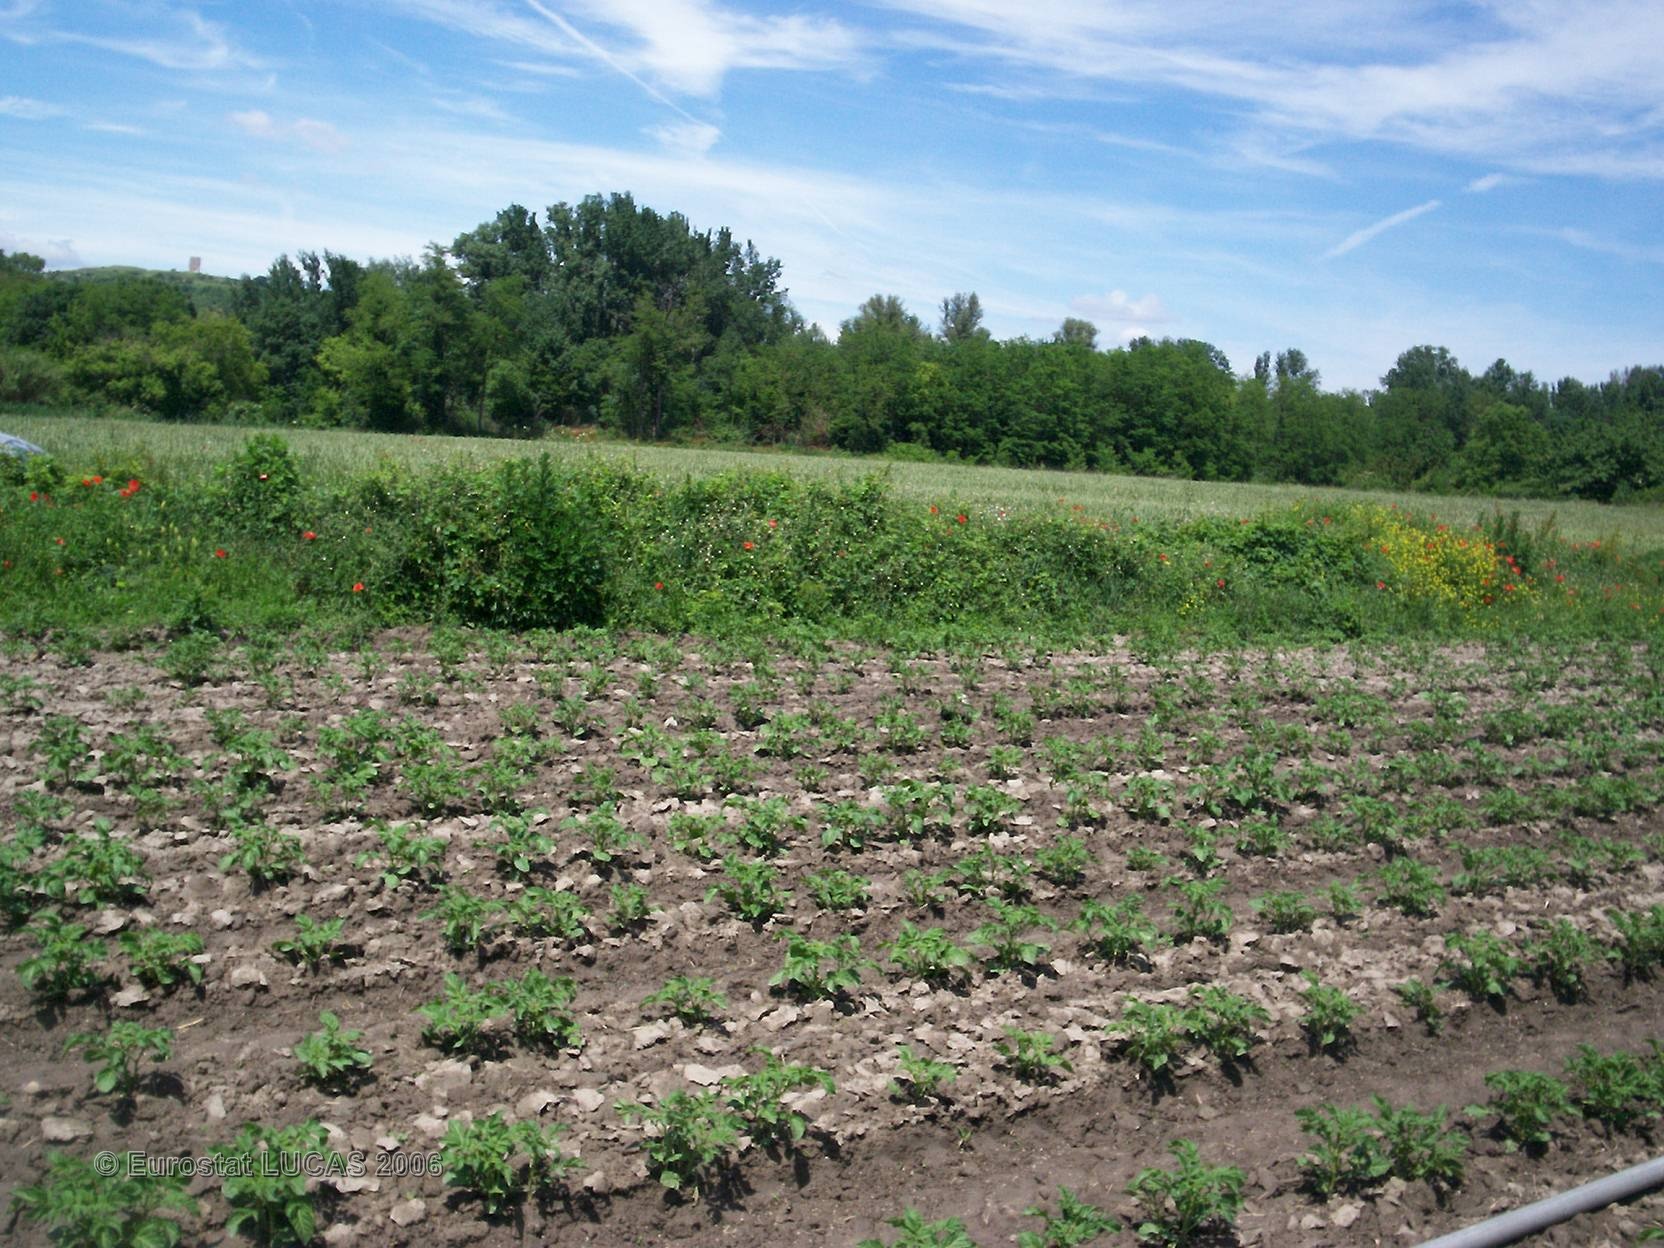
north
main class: Cropland
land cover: Potatoes
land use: Agriculture (excluding fallow land and kitchen gardens)
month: May
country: FR
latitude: 44.8733
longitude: 4.8541
